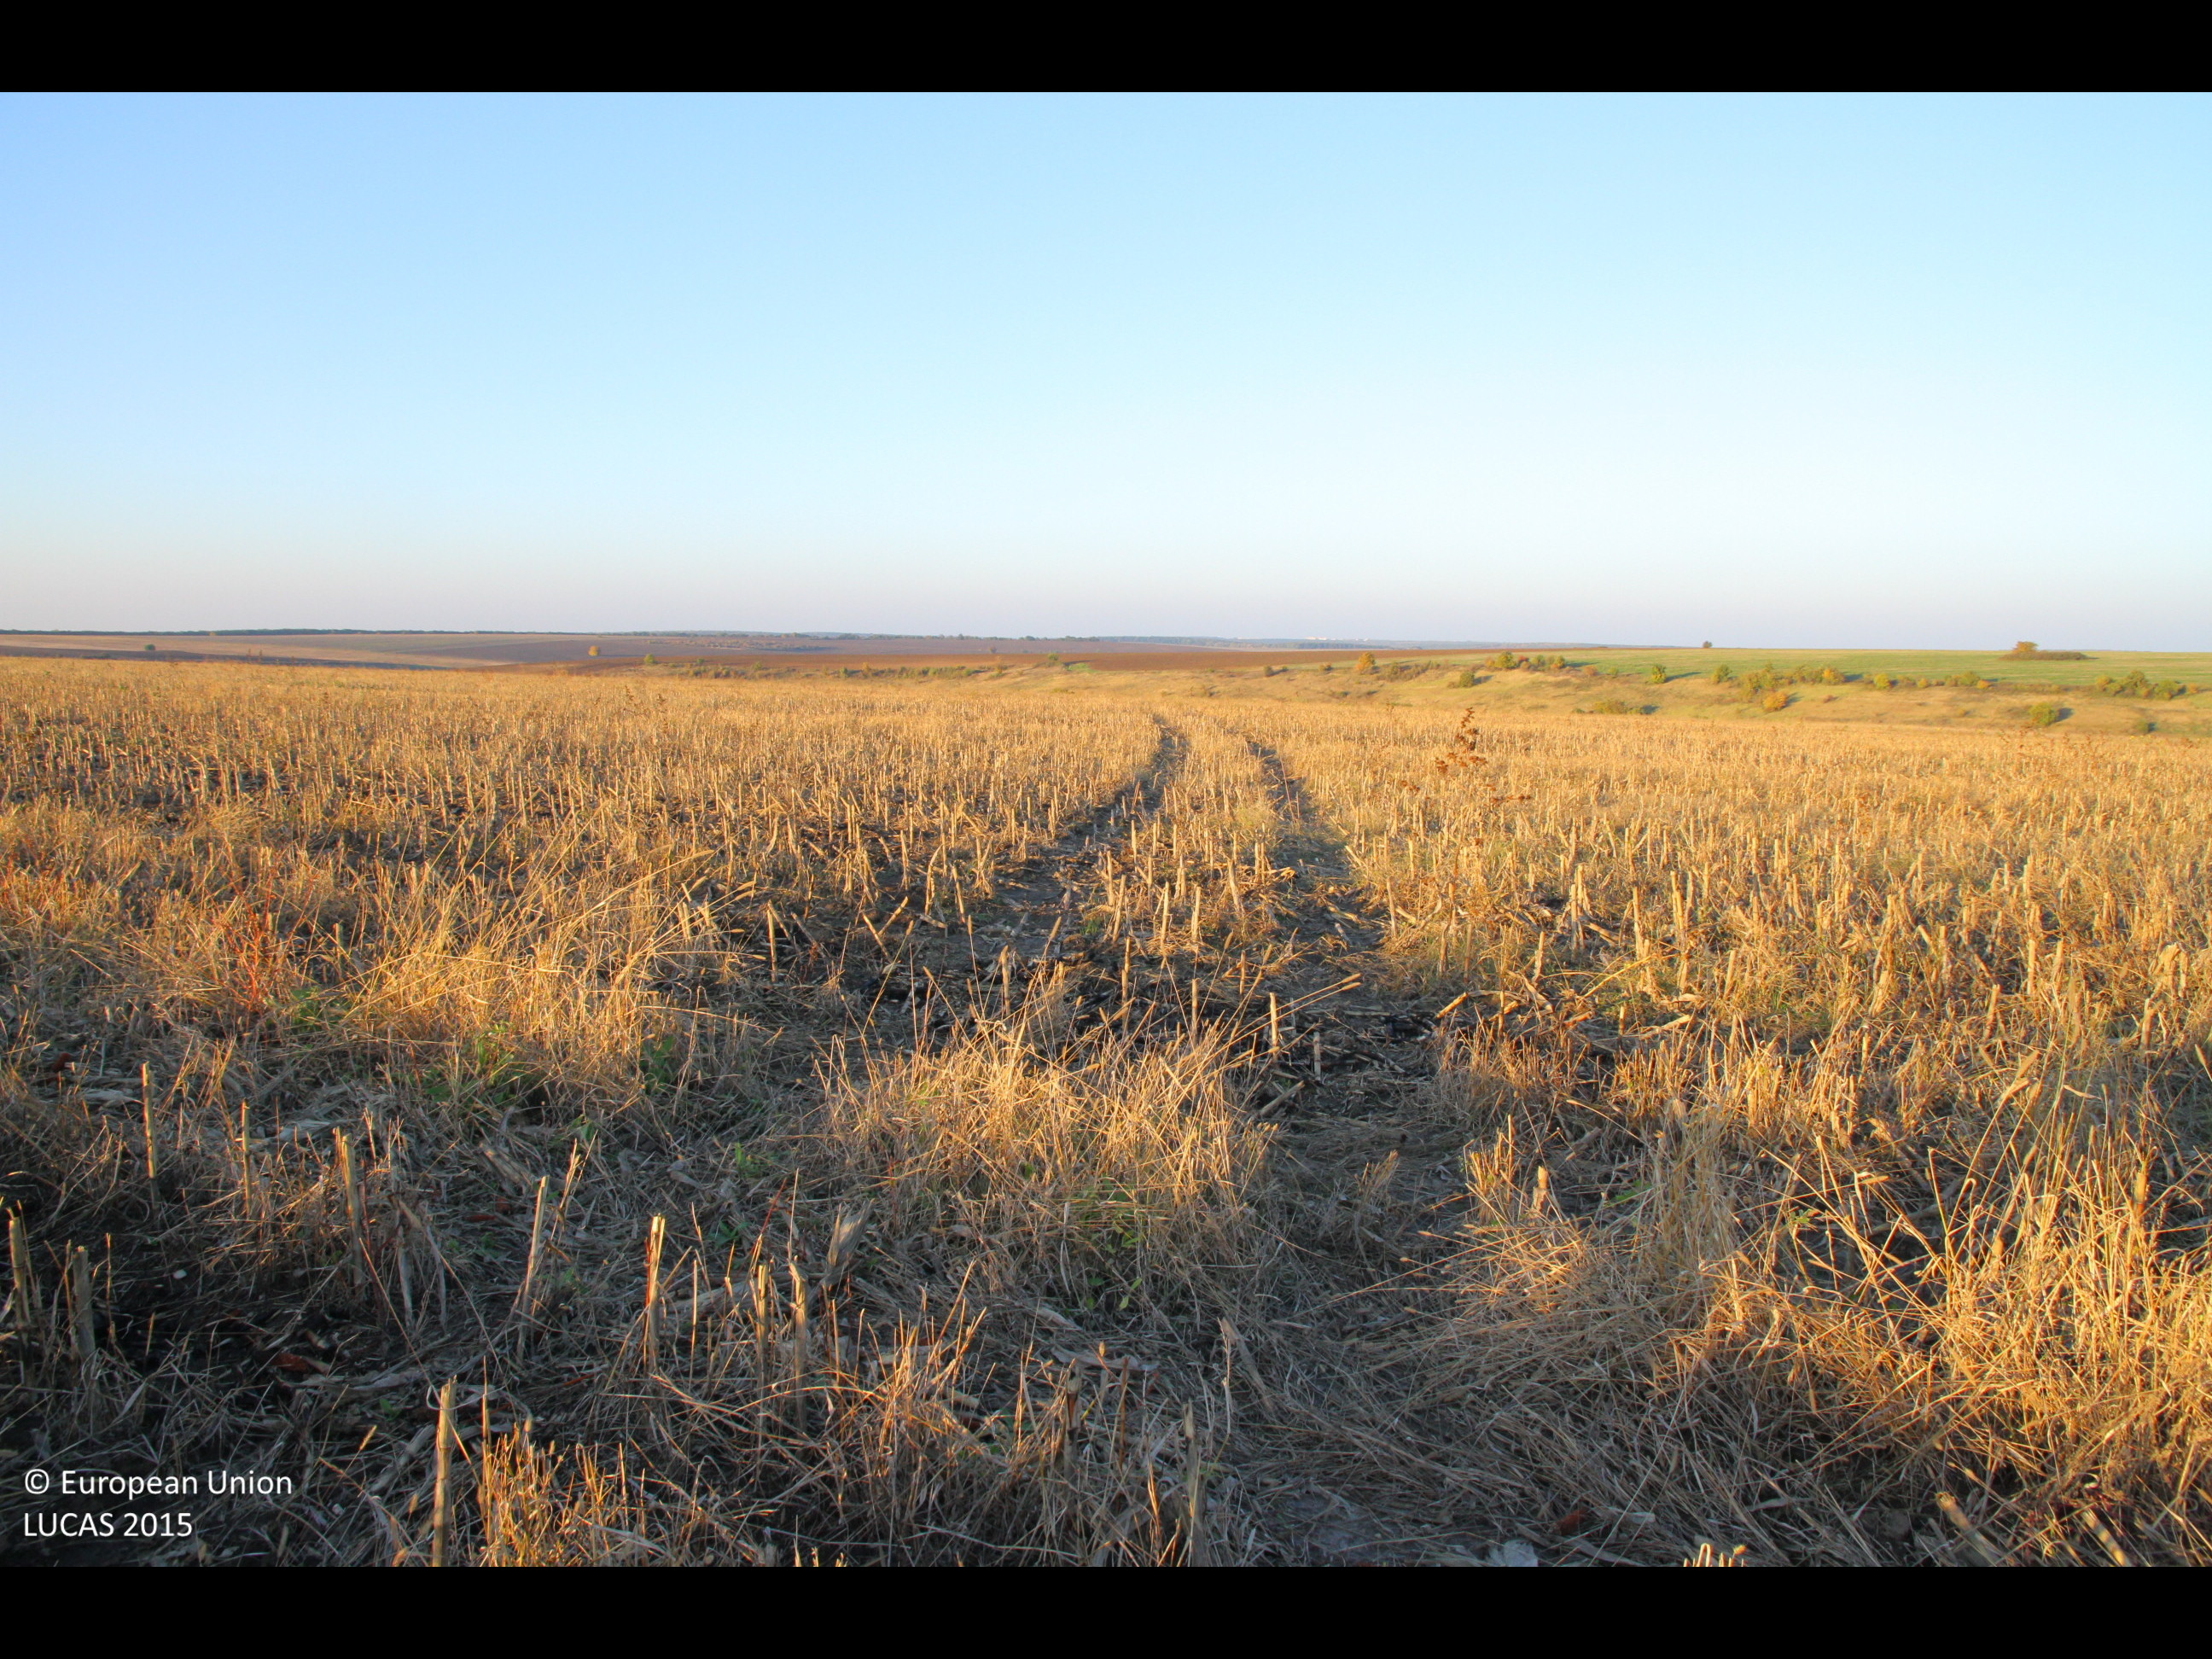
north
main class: Cropland
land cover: Maize
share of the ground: 10 - 25 %
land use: Agriculture (excluding fallow land and kitchen gardens)
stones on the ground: < 10 %
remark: Harvested field
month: October
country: BG
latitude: 43.7069
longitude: 26.4496
